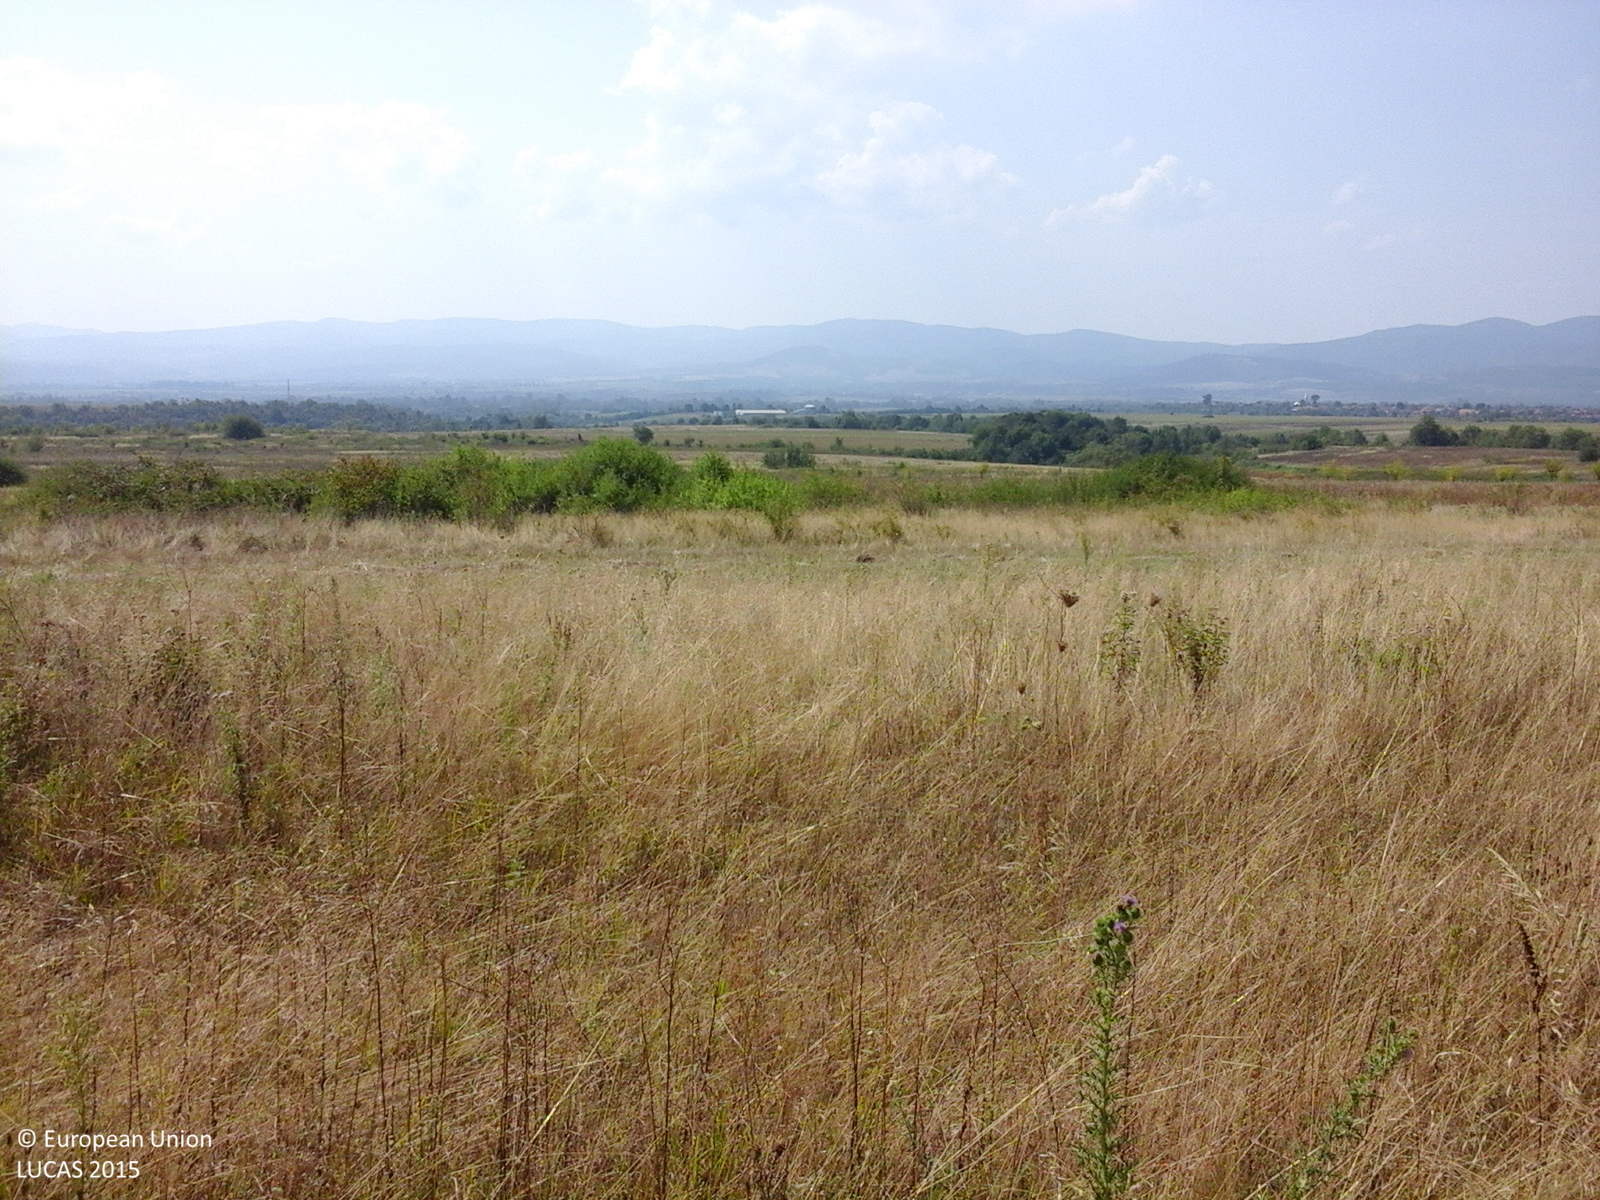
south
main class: Grassland
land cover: Grassland without tree/shrub cover
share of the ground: > 75 %
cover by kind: herbaceous plants 100 %
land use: Agriculture (excluding fallow land and kitchen gardens)
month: August
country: RO
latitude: 46.3335
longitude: 22.2714
